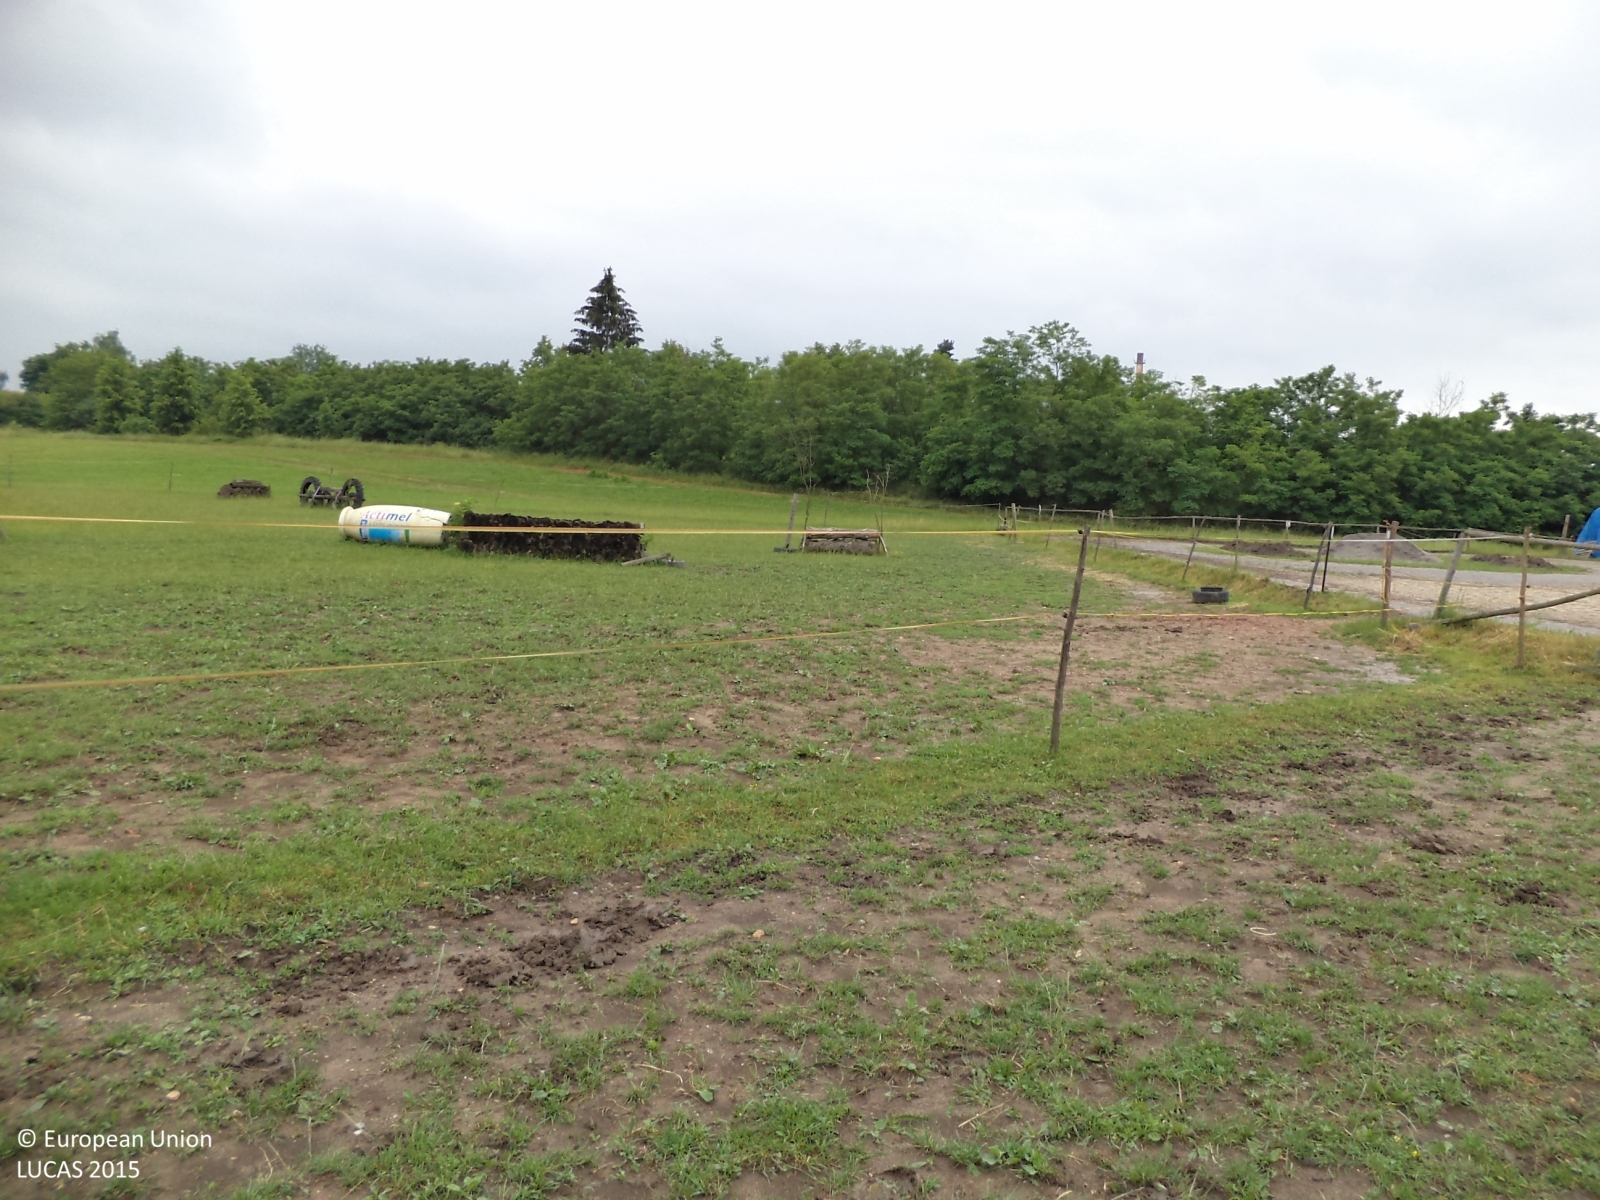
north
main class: Grassland
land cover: Grassland without tree/shrub cover
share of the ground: > 75 %
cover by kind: herbaceous plants 100 %
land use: Agriculture (excluding fallow land and kitchen gardens)
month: June
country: CZ
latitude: 49.2165
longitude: 14.4080
